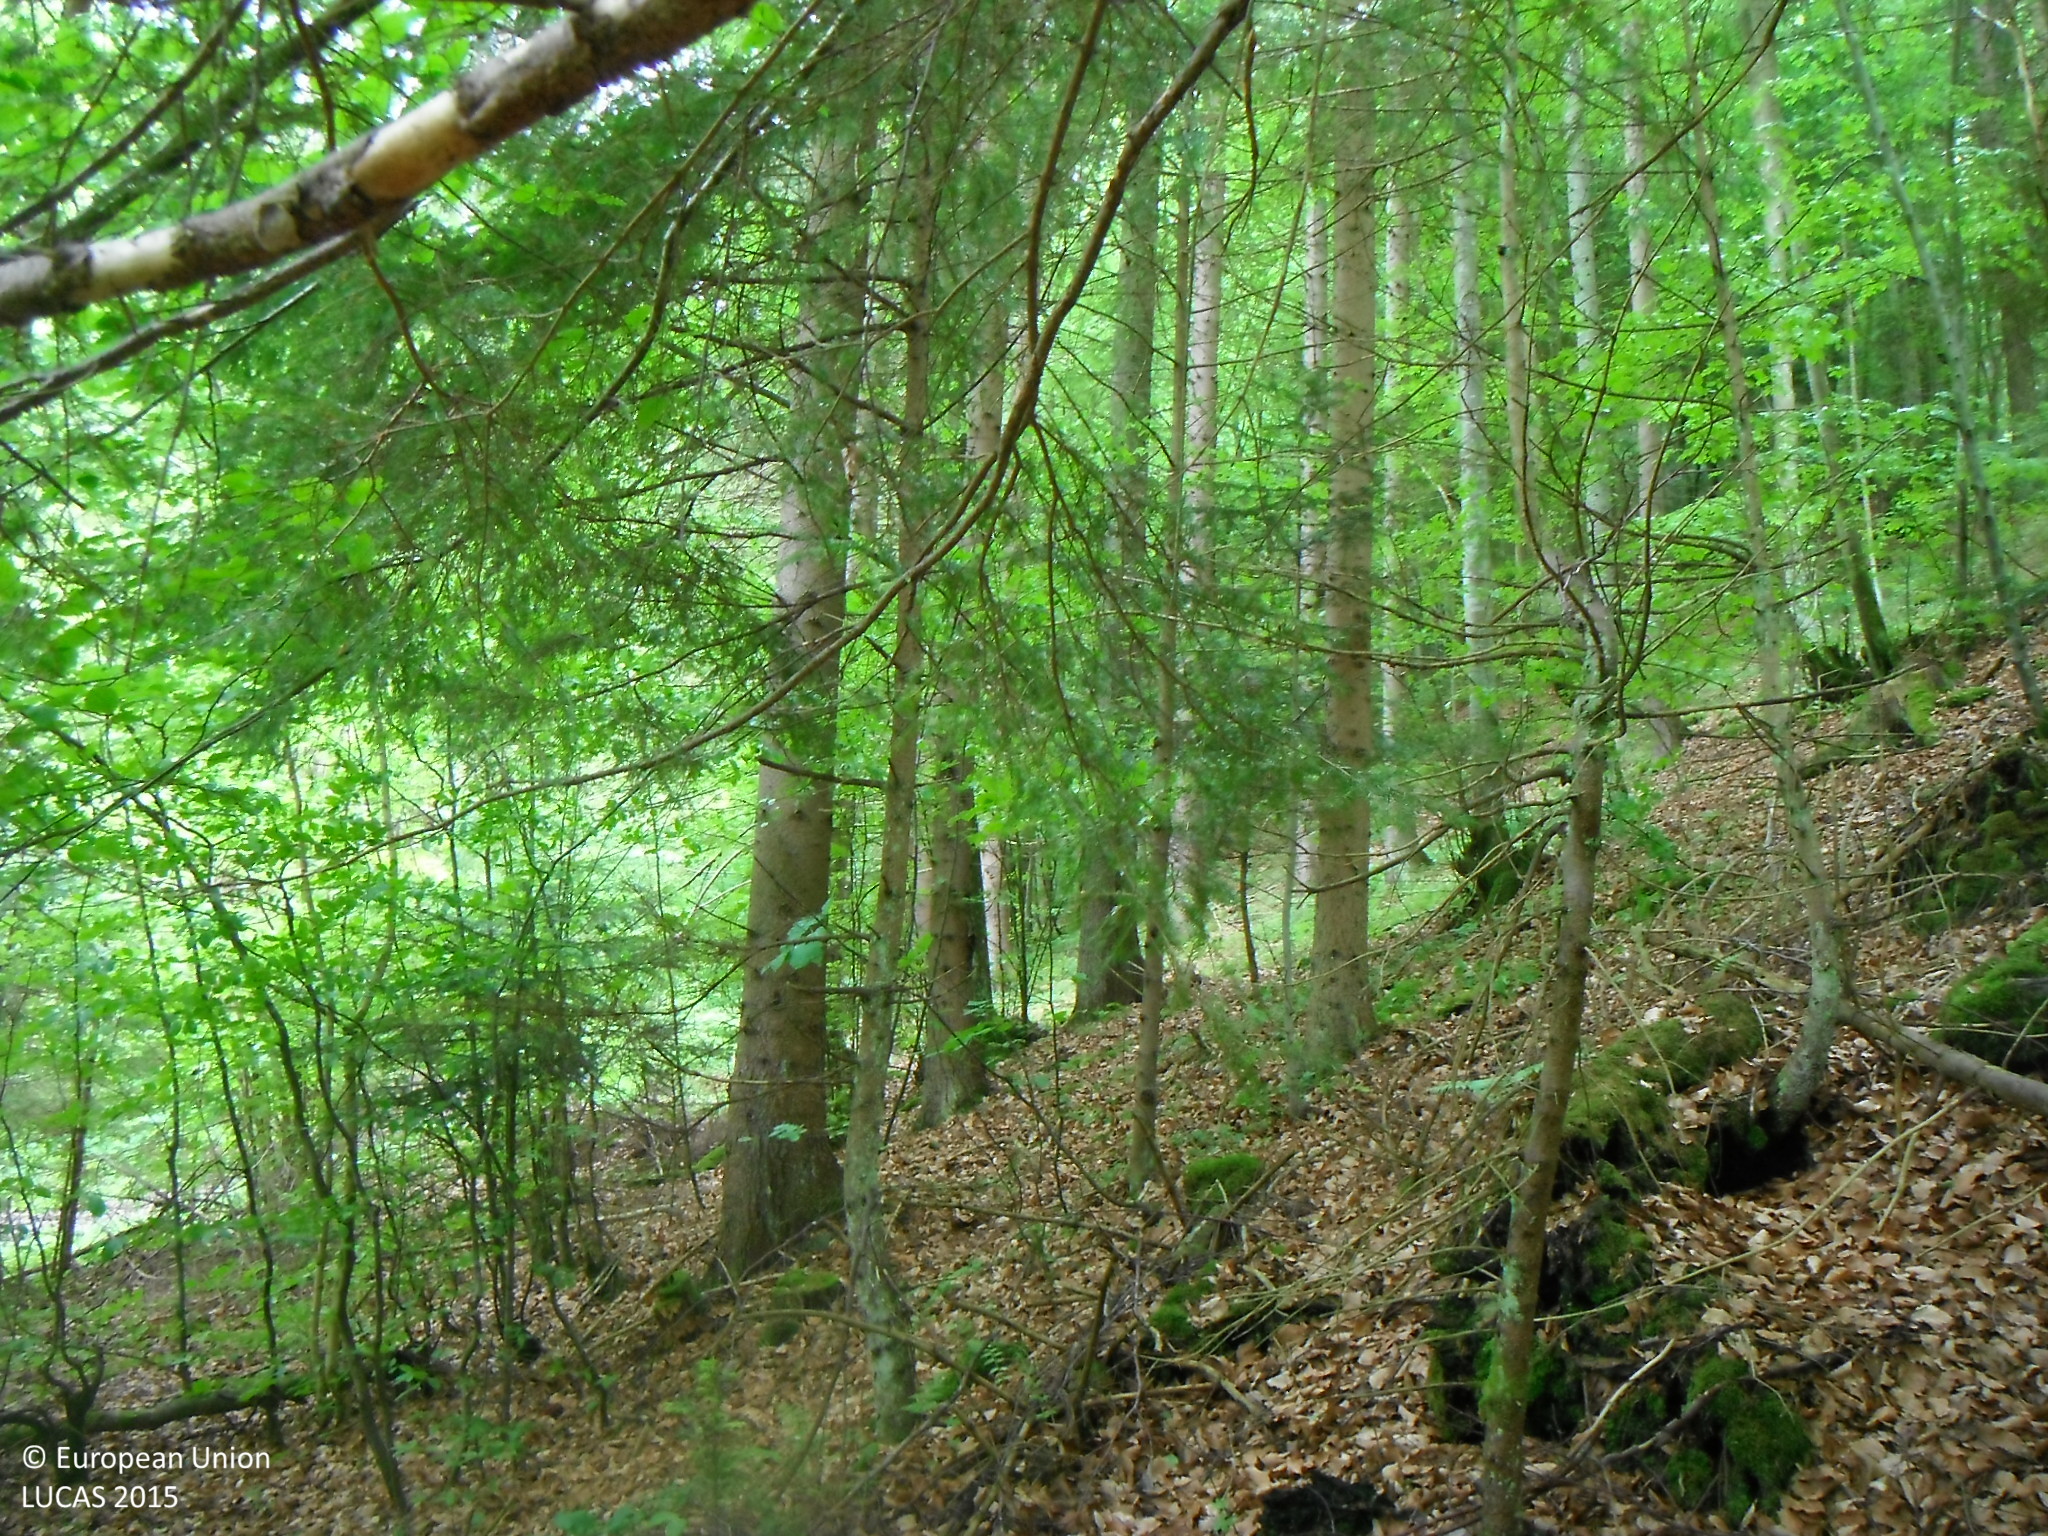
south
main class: Woodland
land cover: Spruce dominated mixed woodland
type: hemiboreal forest and nemoral coniferous forest and mixed broadleaved-coniferous forest
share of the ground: > 75 %
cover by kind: coniferous forest trees 70 %, broadleaved forest trees 30 %
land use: Forestry
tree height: > 5 m
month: May
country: SK
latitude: 49.0086
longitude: 19.0588
